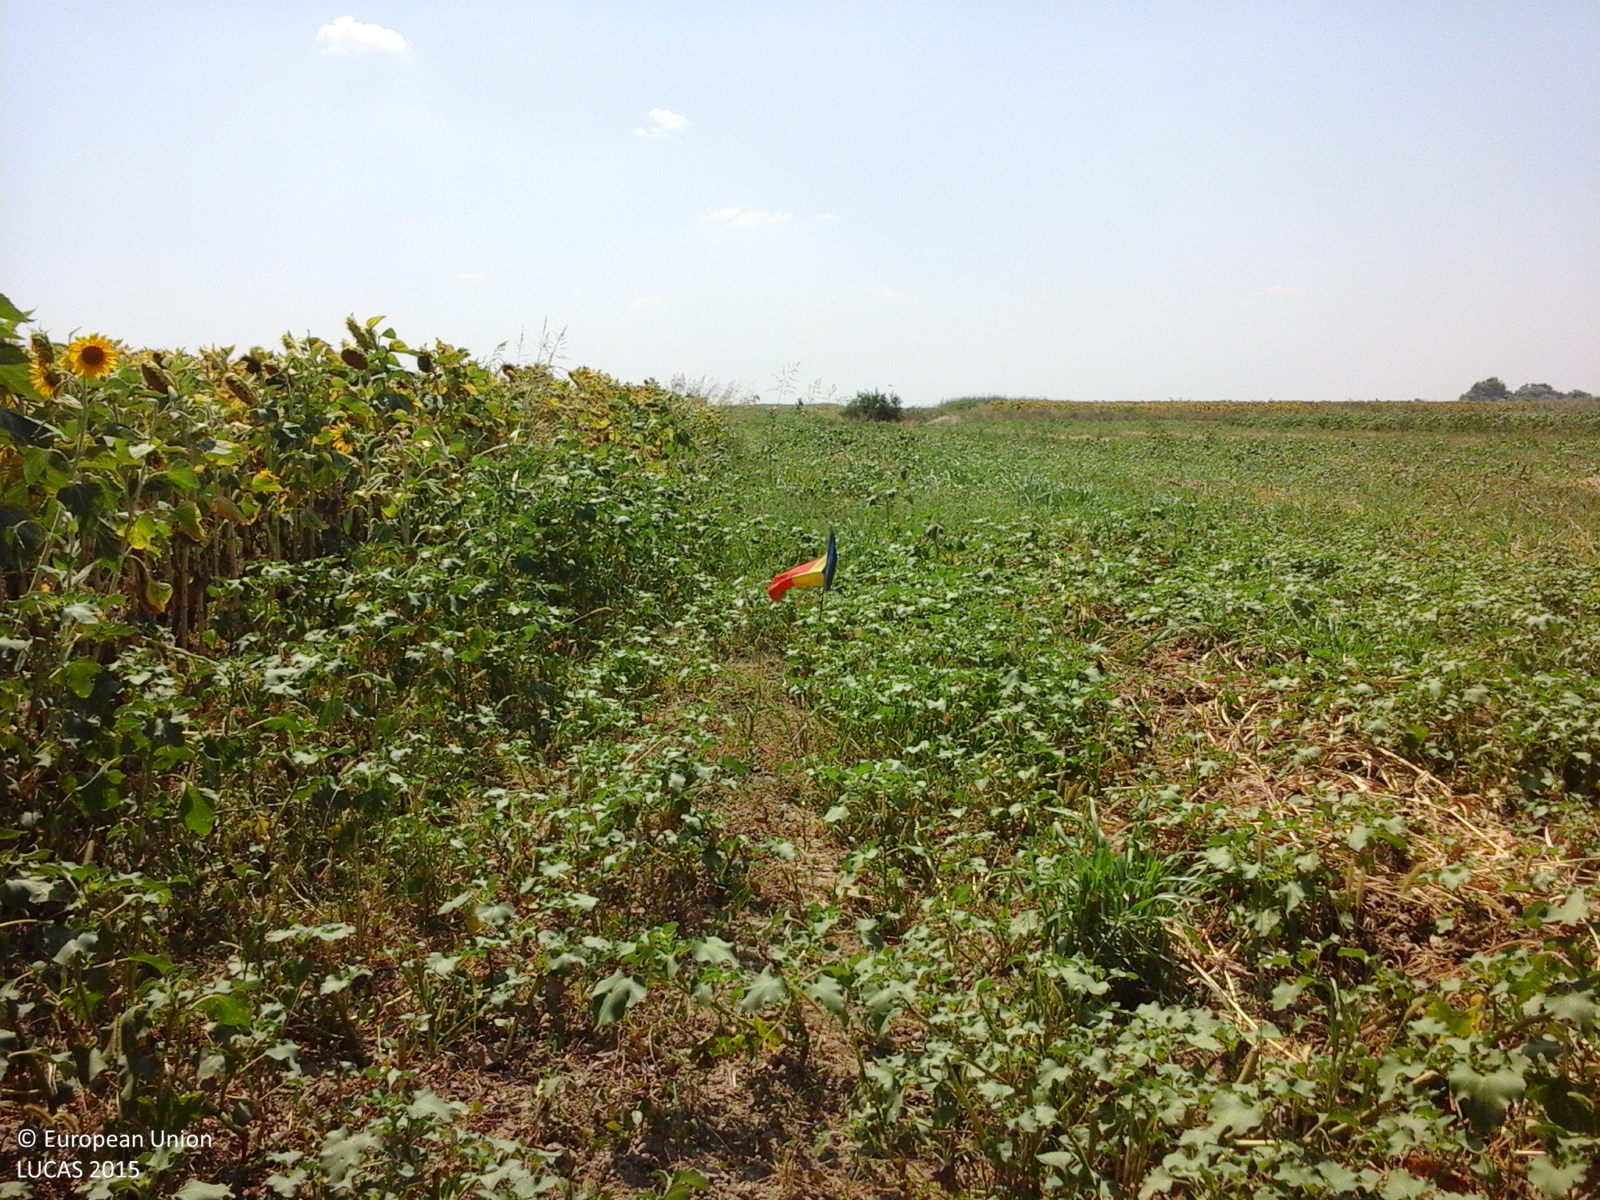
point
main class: Grassland
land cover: Spontaneously vegetated surfaces
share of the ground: > 75 %
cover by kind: herbaceous plants 100 %
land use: Agriculture (excluding fallow land and kitchen gardens)
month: August
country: RO
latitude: 45.1482
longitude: 27.3017
